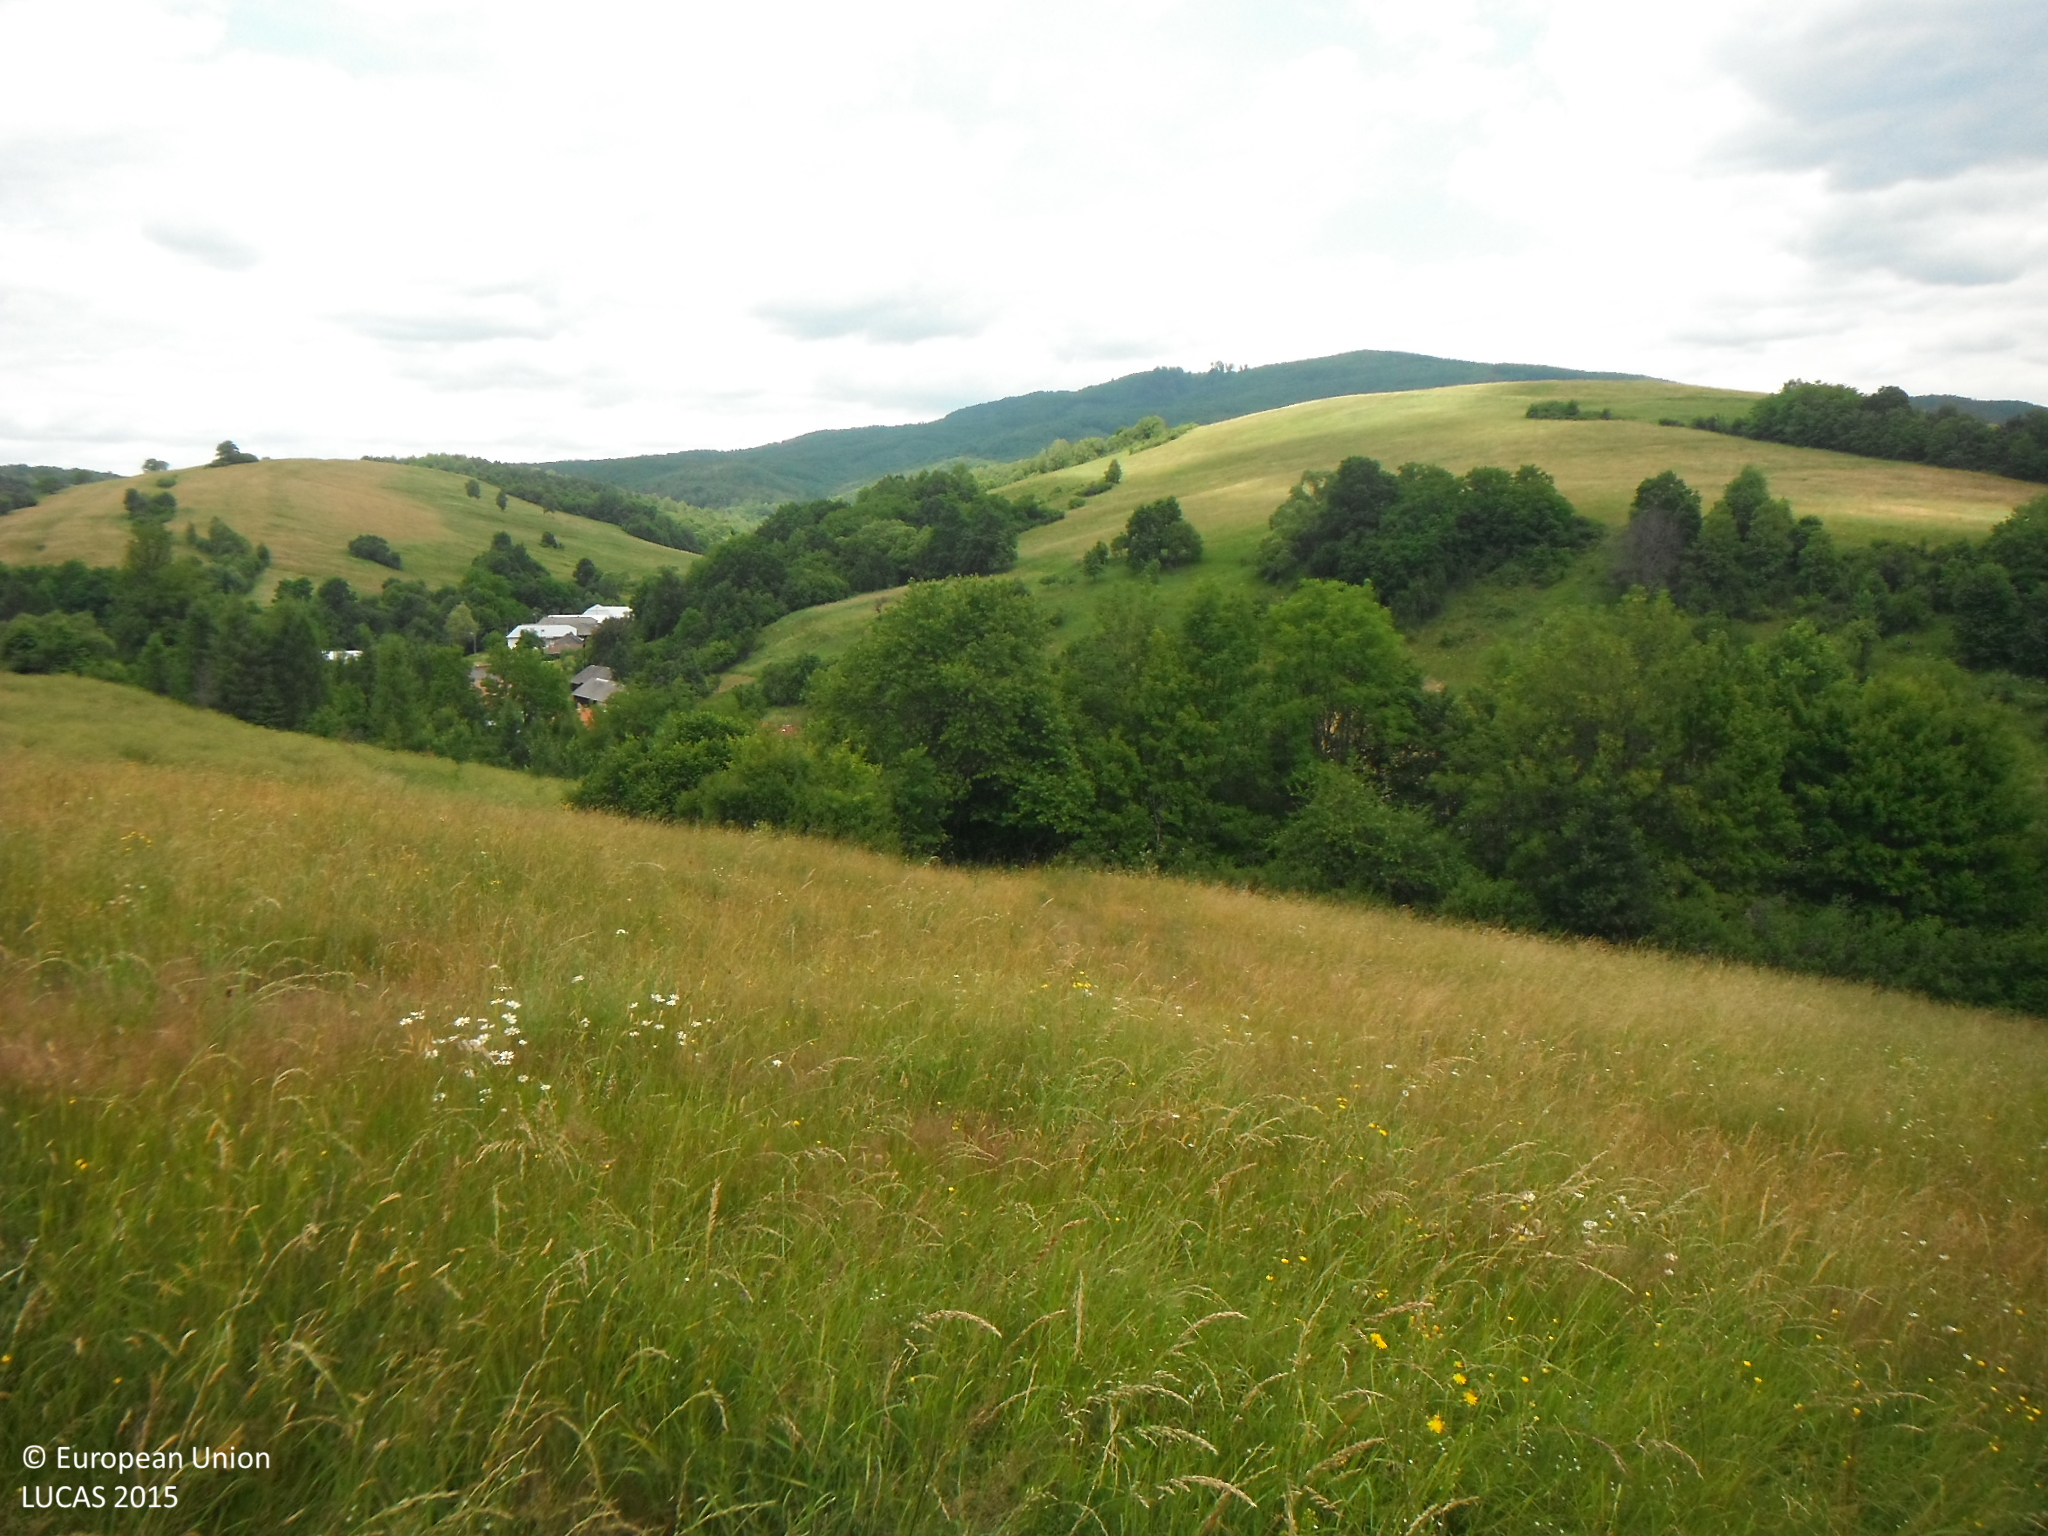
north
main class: Grassland
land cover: Grassland without tree/shrub cover
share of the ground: > 75 %
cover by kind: herbaceous plants 100 %
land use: Agriculture (excluding fallow land and kitchen gardens)
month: June
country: SK
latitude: 48.9442
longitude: 22.3628
